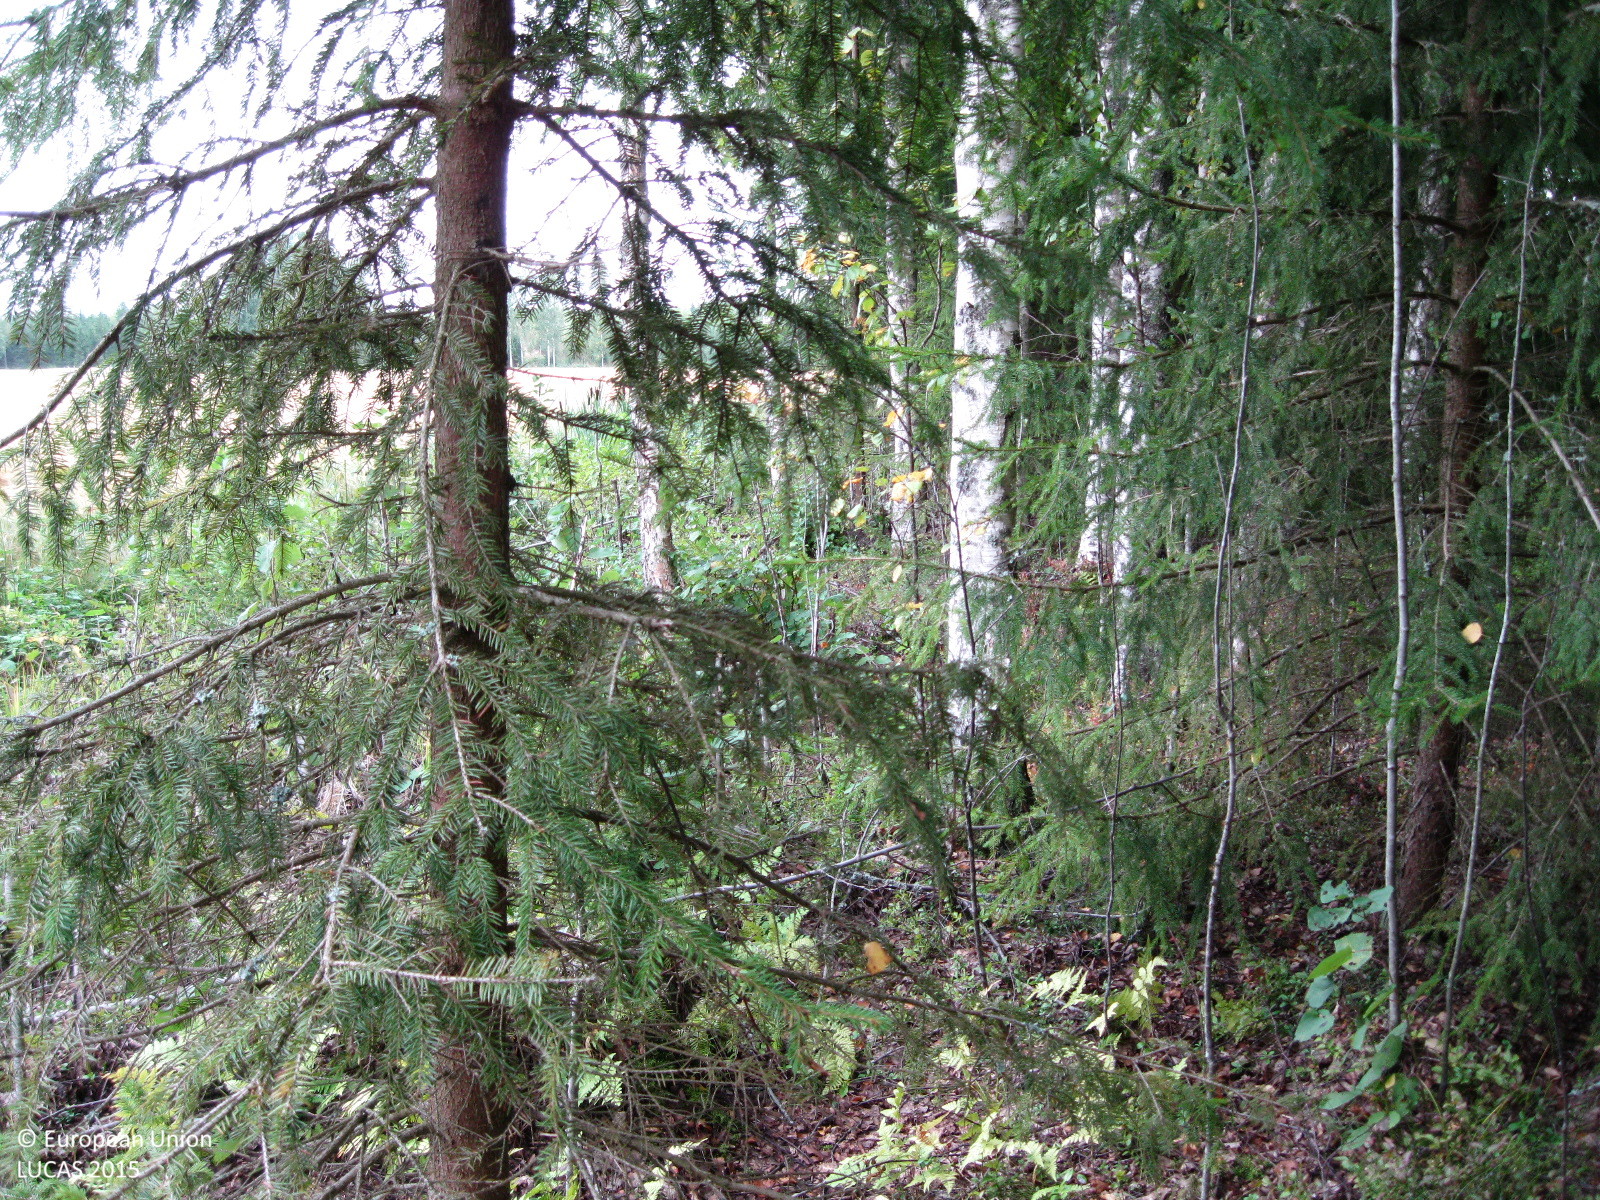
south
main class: Woodland
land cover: Spruce dominated mixed woodland
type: boreal forest
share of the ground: > 75 %
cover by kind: broadleaved forest trees 45 %, coniferous forest trees 40 %, herbaceous plants 10 %, shrubs 5 %
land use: Forestry
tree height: > 5 m
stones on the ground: < 10 %
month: September
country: FI
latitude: 60.8523
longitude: 25.0802
